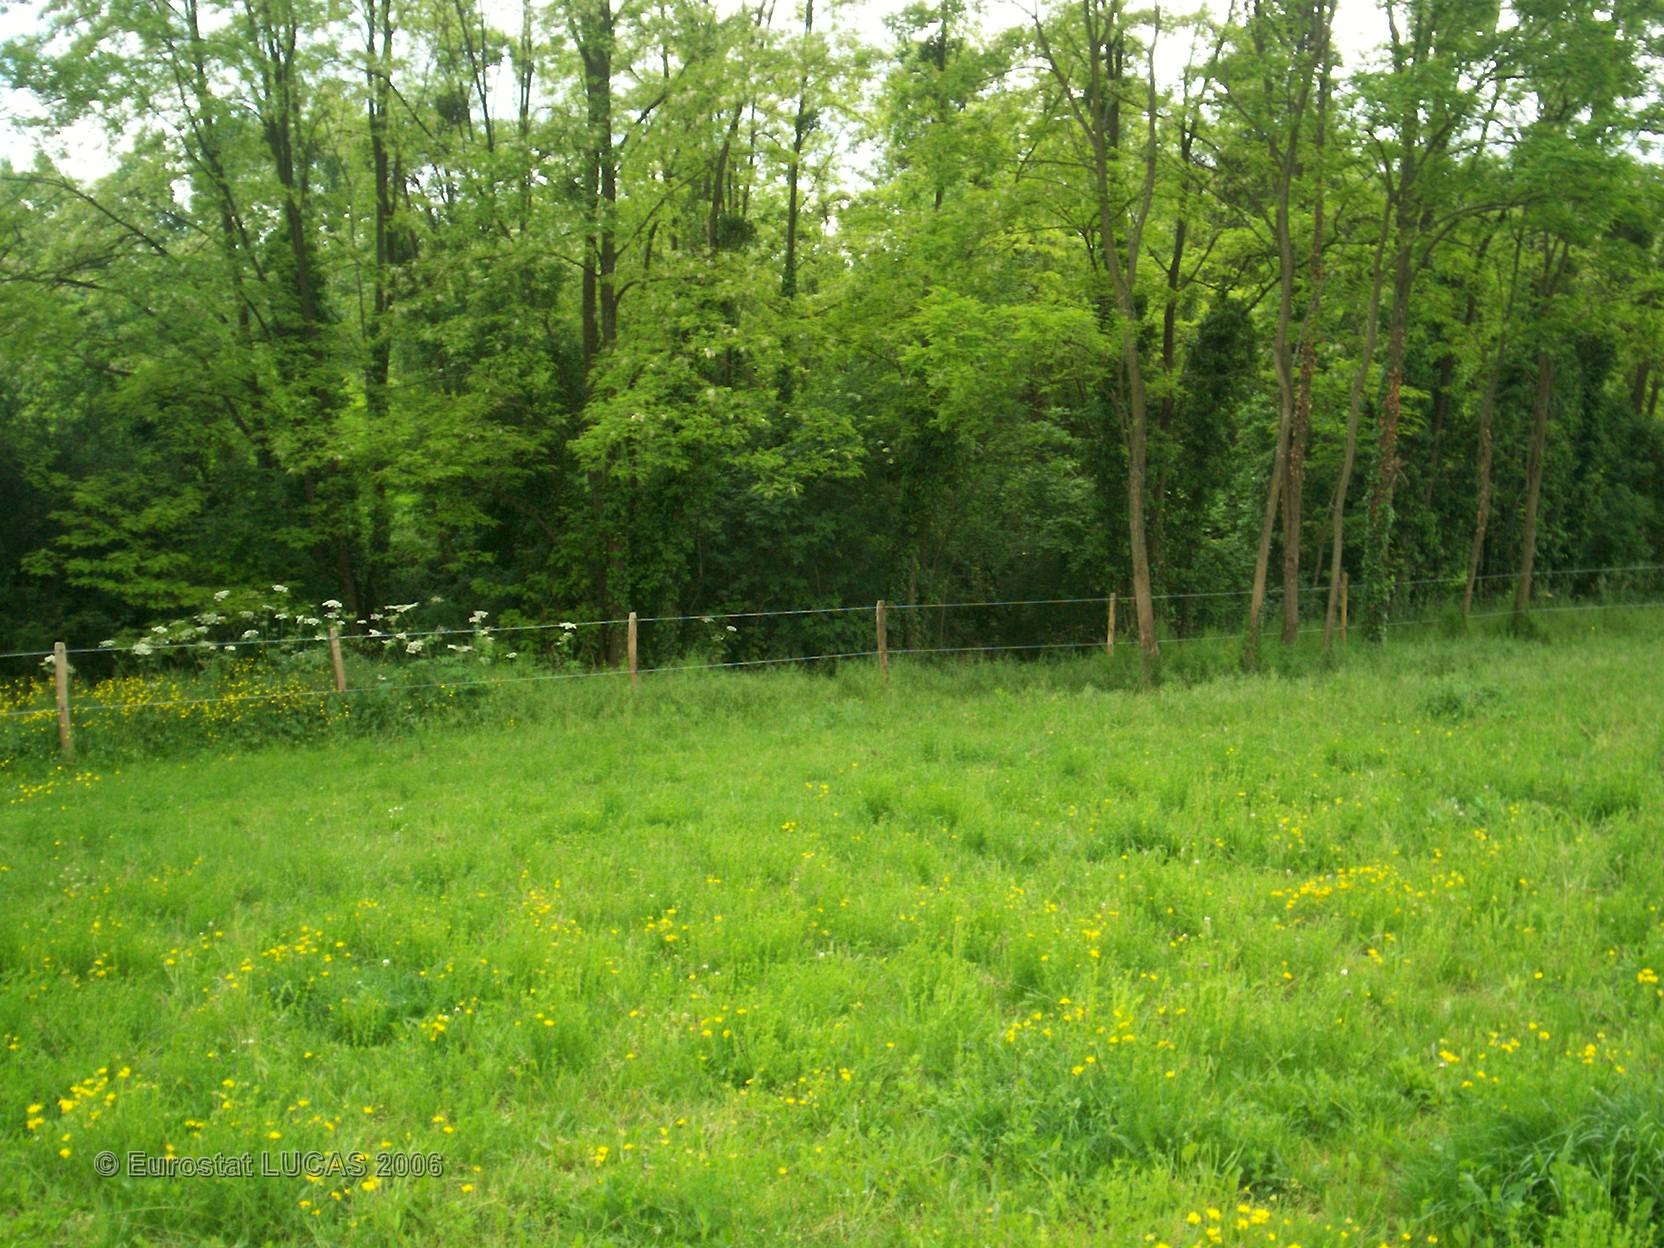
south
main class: Grassland
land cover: Grassland without tree/shrub cover
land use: Agriculture (excluding fallow land and kitchen gardens)
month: May
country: FR
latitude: 46.9048
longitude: 4.6839
